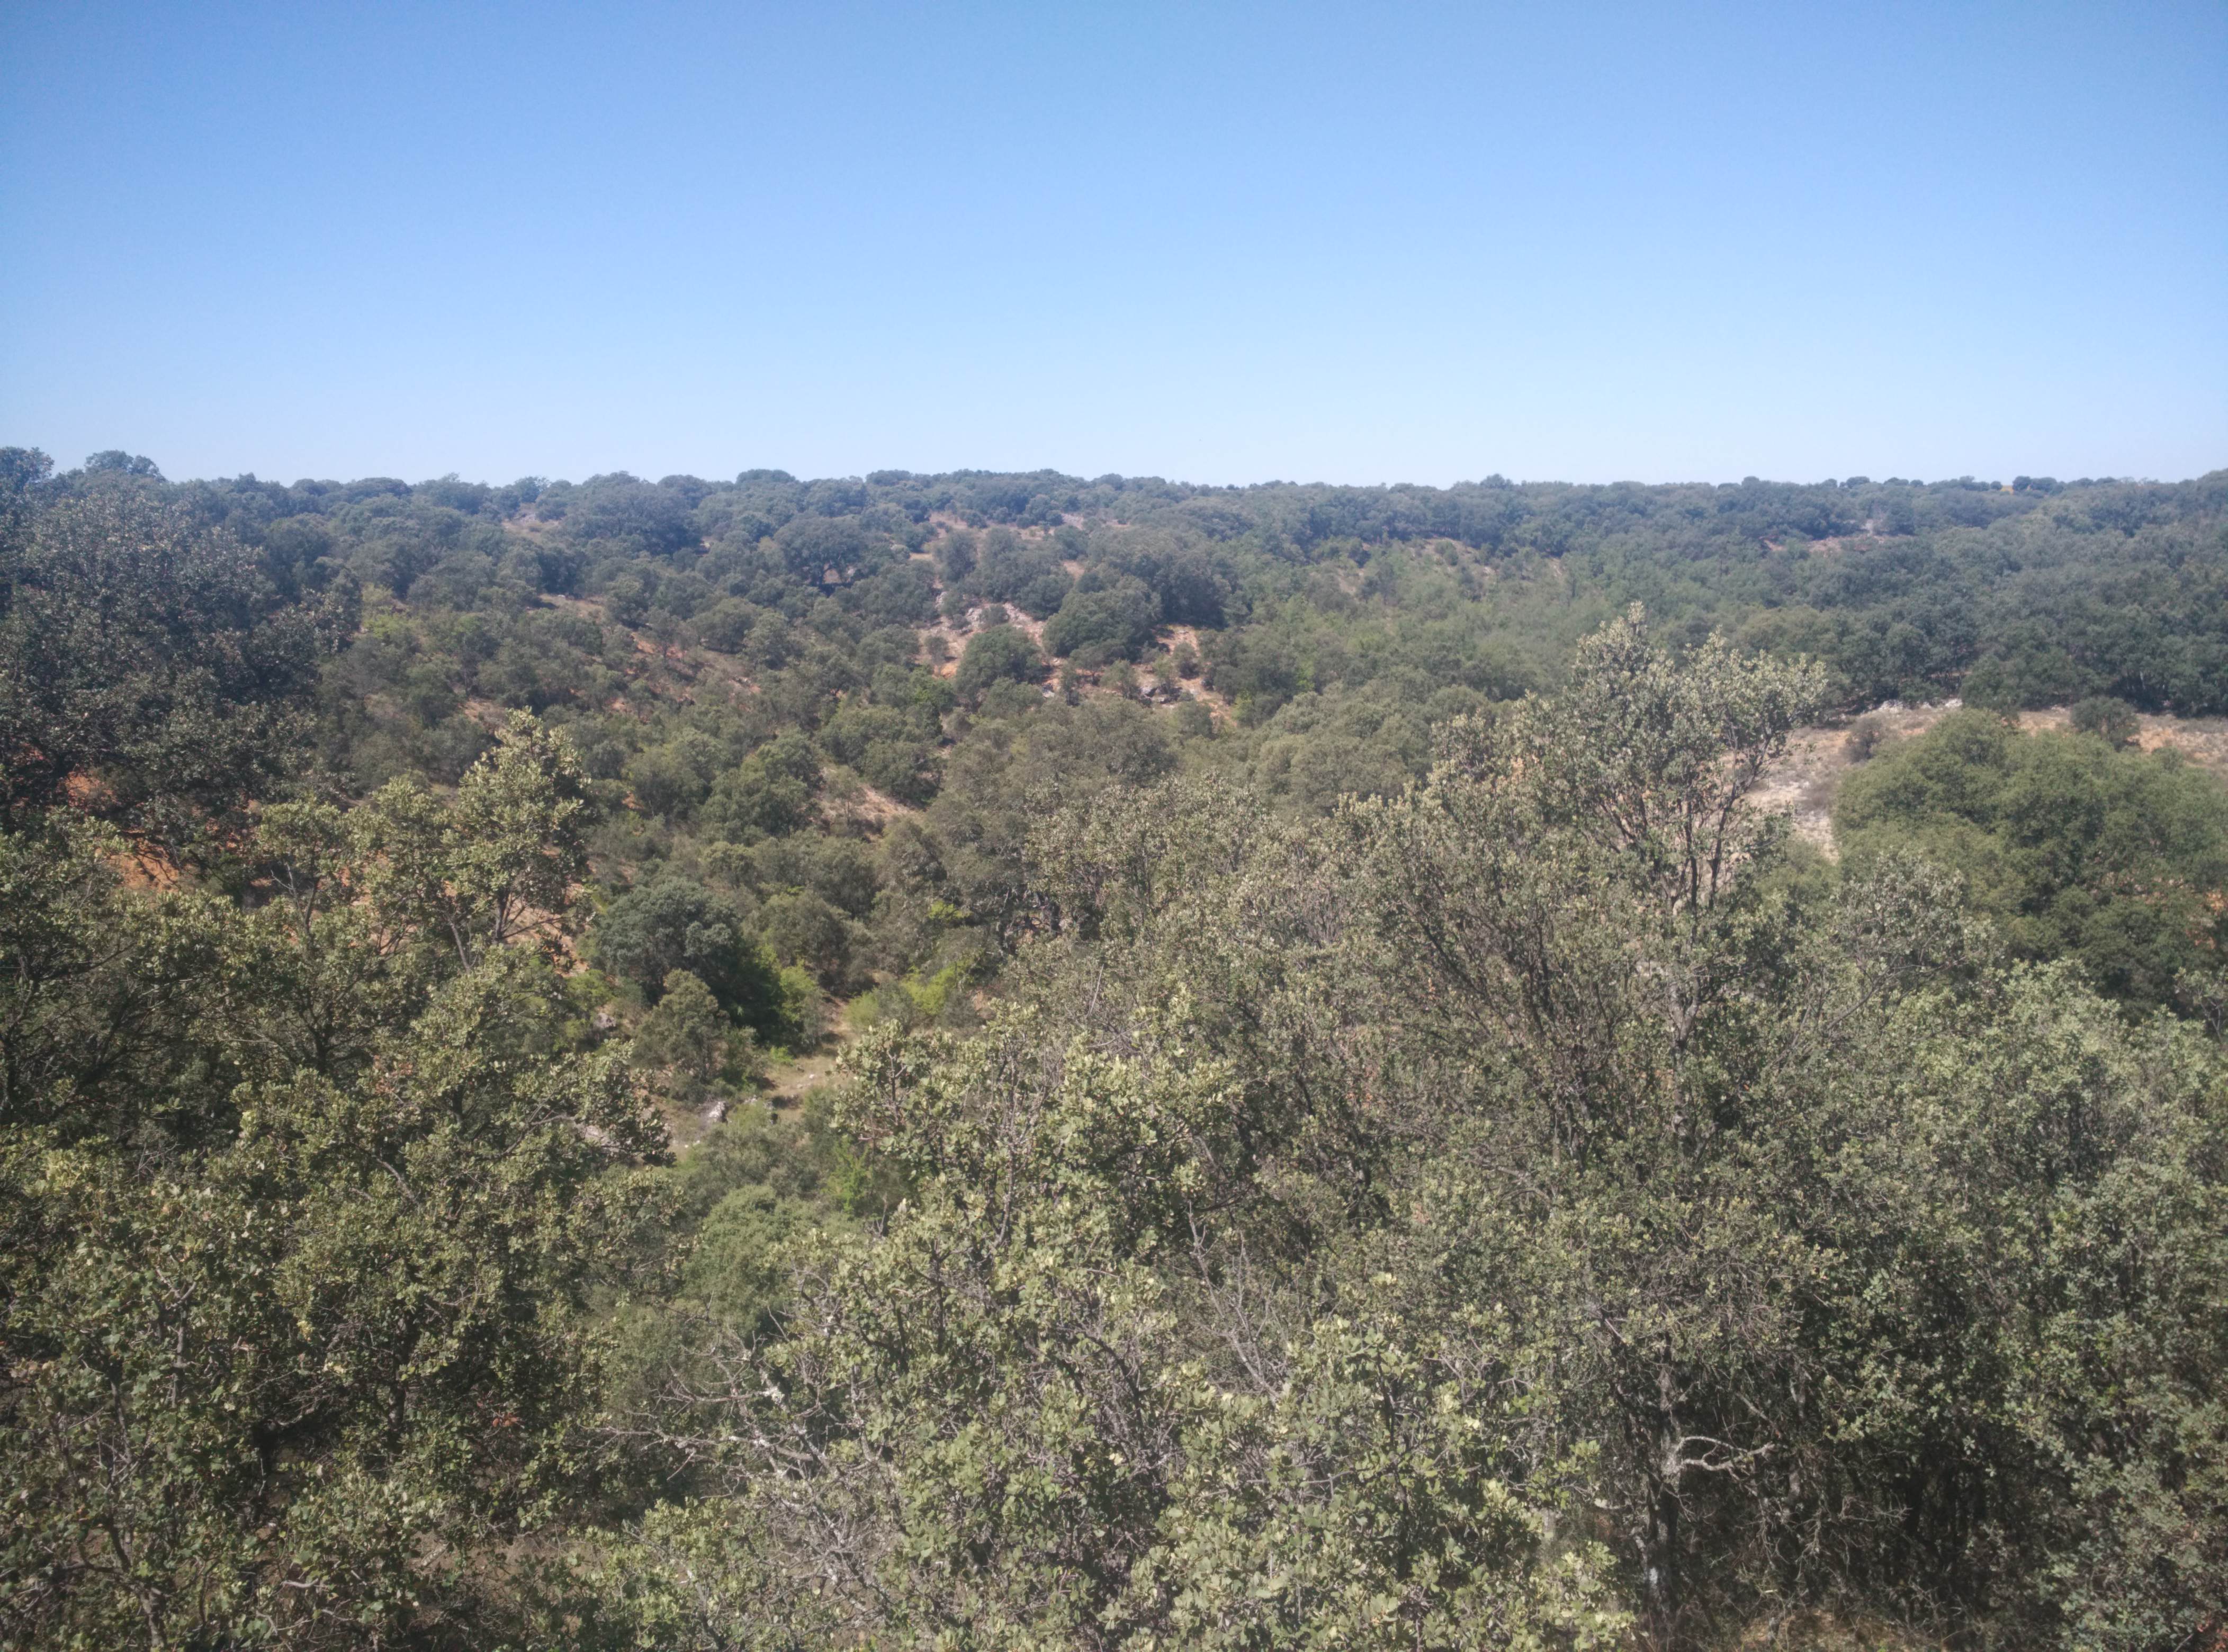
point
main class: Woodland
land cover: Broadleaved woodland
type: thermophilous deciduous forest
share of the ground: 25 - 50 %
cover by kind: broadleaved forest trees 40 %, unconsolidated bare surface 40 %, shrubs 20 %
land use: Semi-natural and natural areas not in use
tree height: > 5 m
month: July
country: ES
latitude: 40.6635
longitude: -2.8403
